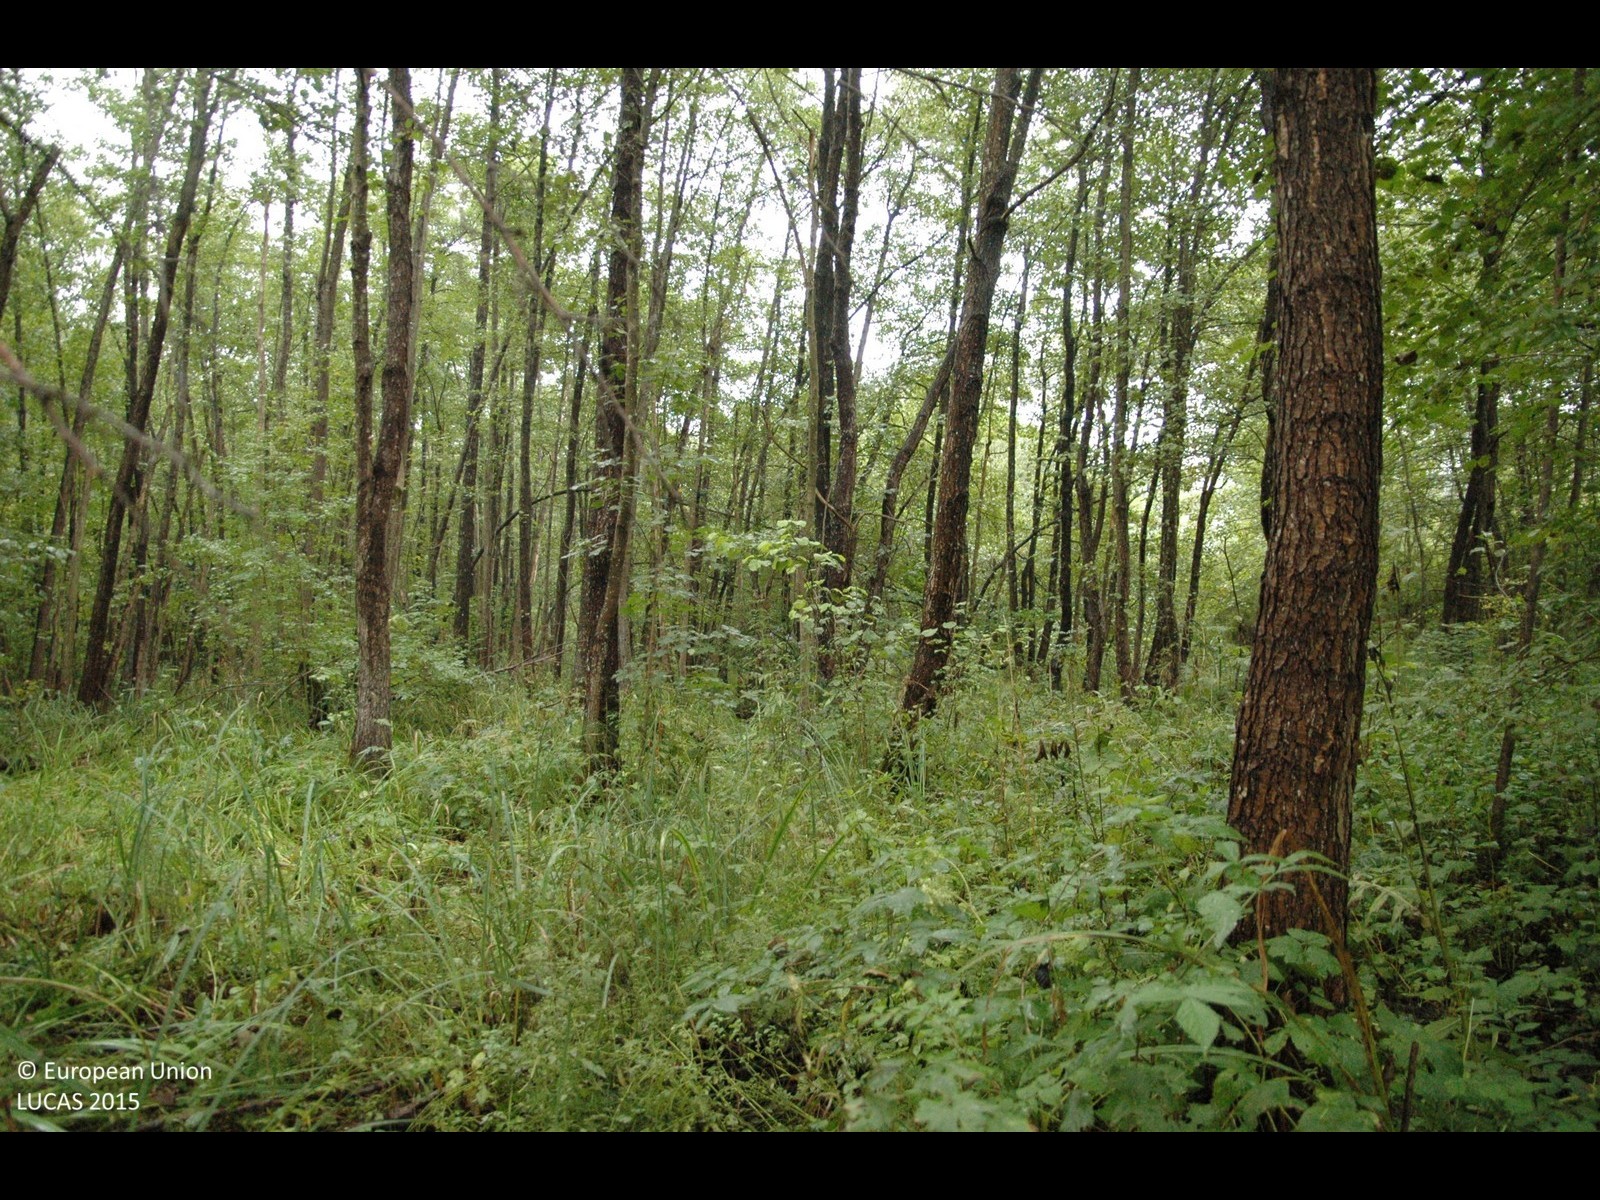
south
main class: Woodland
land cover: Broadleaved woodland
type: mesophytic deciduous forest
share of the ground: > 75 %
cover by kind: broadleaved forest trees 100 %
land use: Semi-natural and natural areas not in use
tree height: > 5 m
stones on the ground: < 10 %
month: October
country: HR
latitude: 45.1559
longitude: 15.2740
